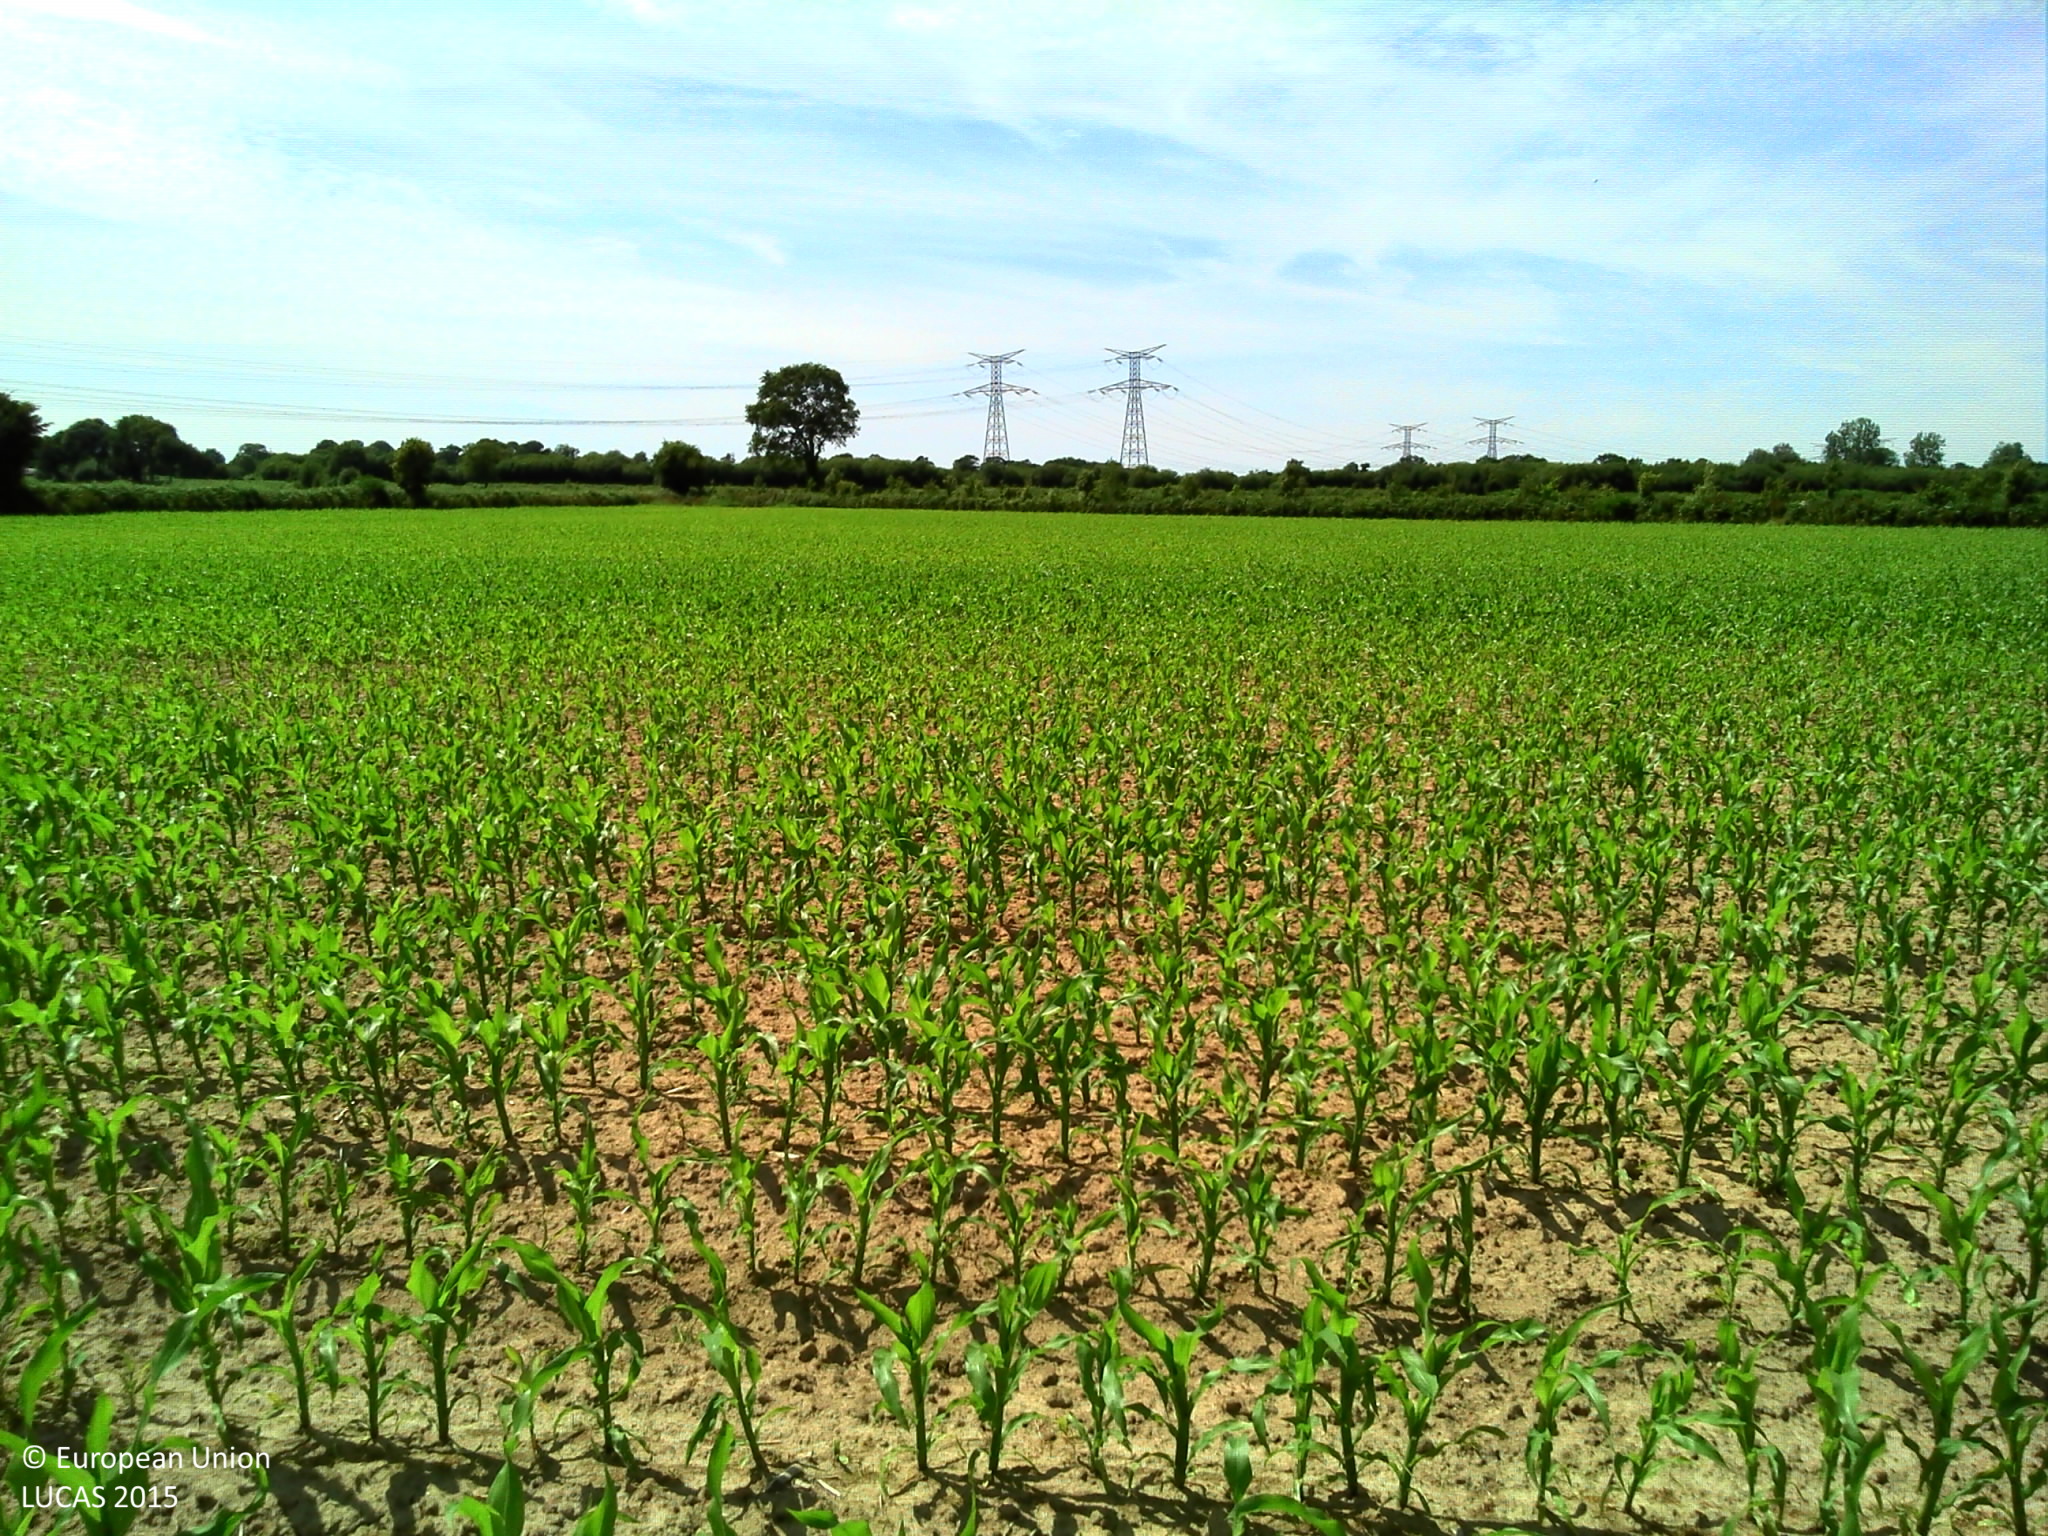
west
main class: Cropland
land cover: Maize
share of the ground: 25 - 50 %
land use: Agriculture (excluding fallow land and kitchen gardens)
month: June
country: FR
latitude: 49.1808
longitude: -1.3371
